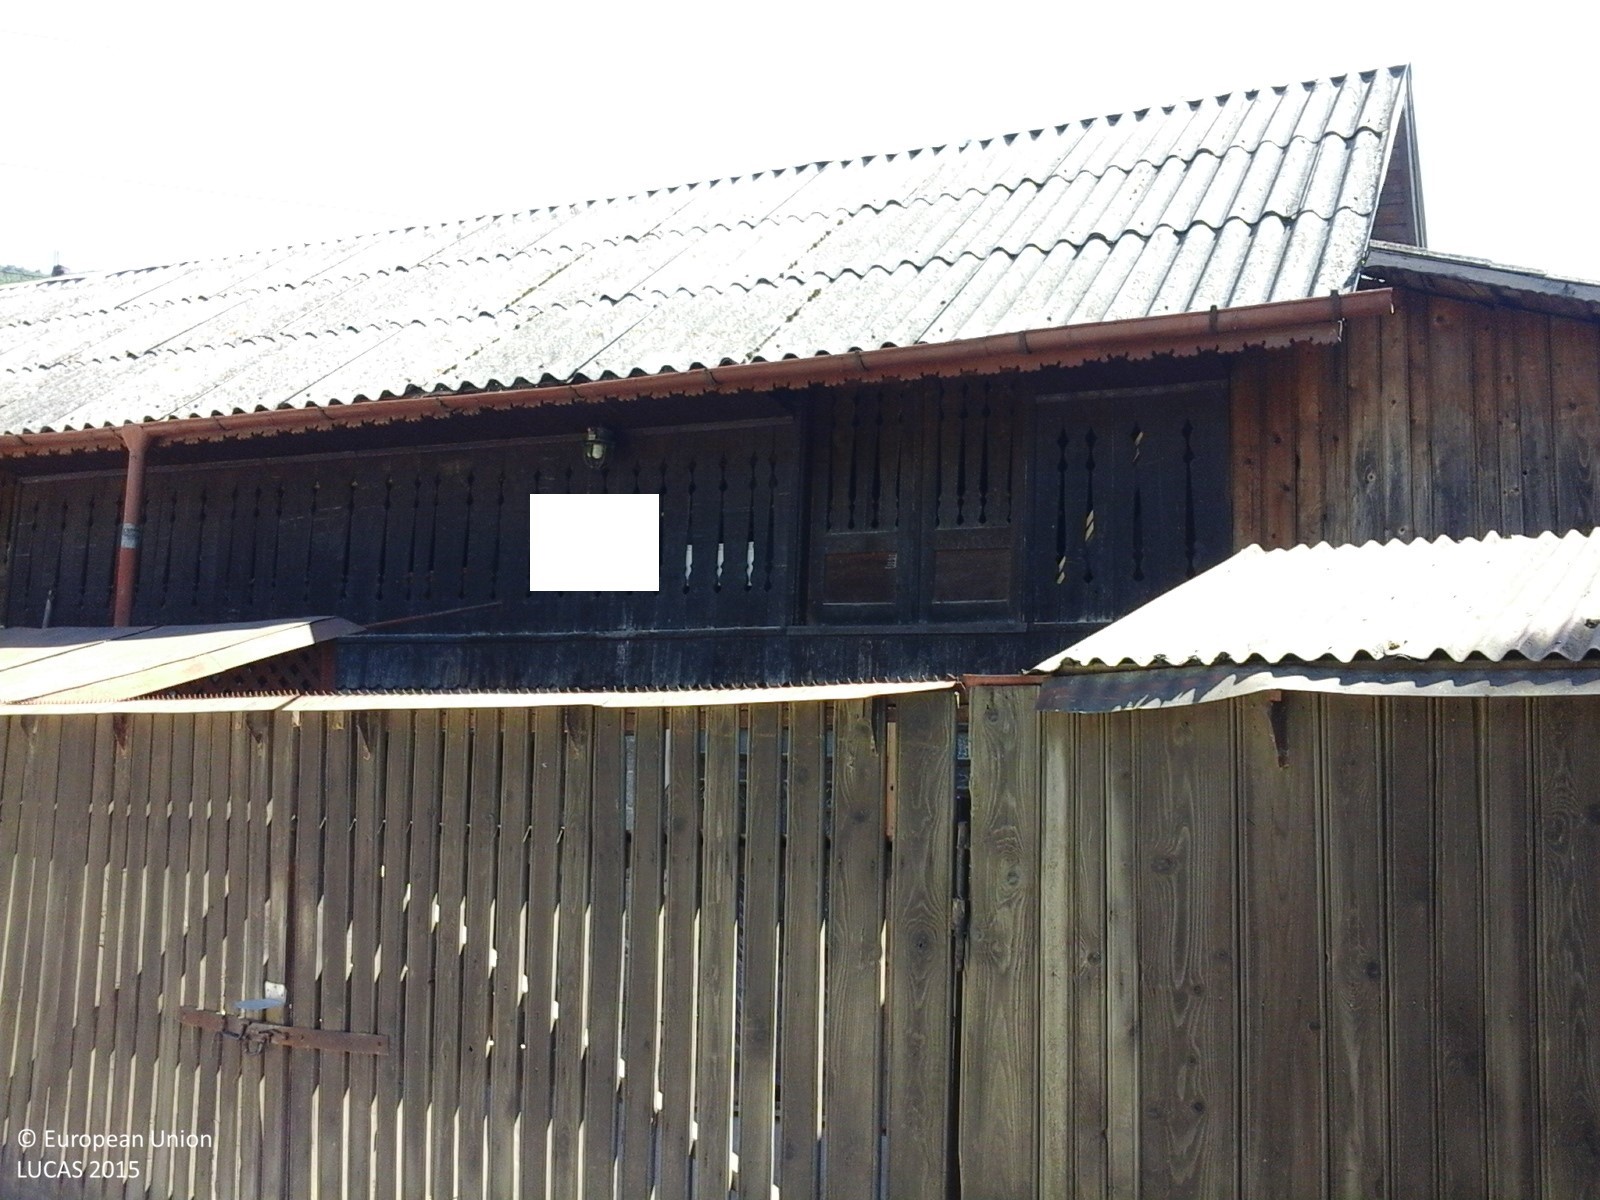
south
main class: Cropland
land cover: Apple fruit
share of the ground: 25 - 50 %
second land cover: Grassland without tree/shrub cover
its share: 50 - 75 %
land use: Agriculture (excluding fallow land and kitchen gardens)
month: June
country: RO
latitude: 45.3885
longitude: 25.1770
